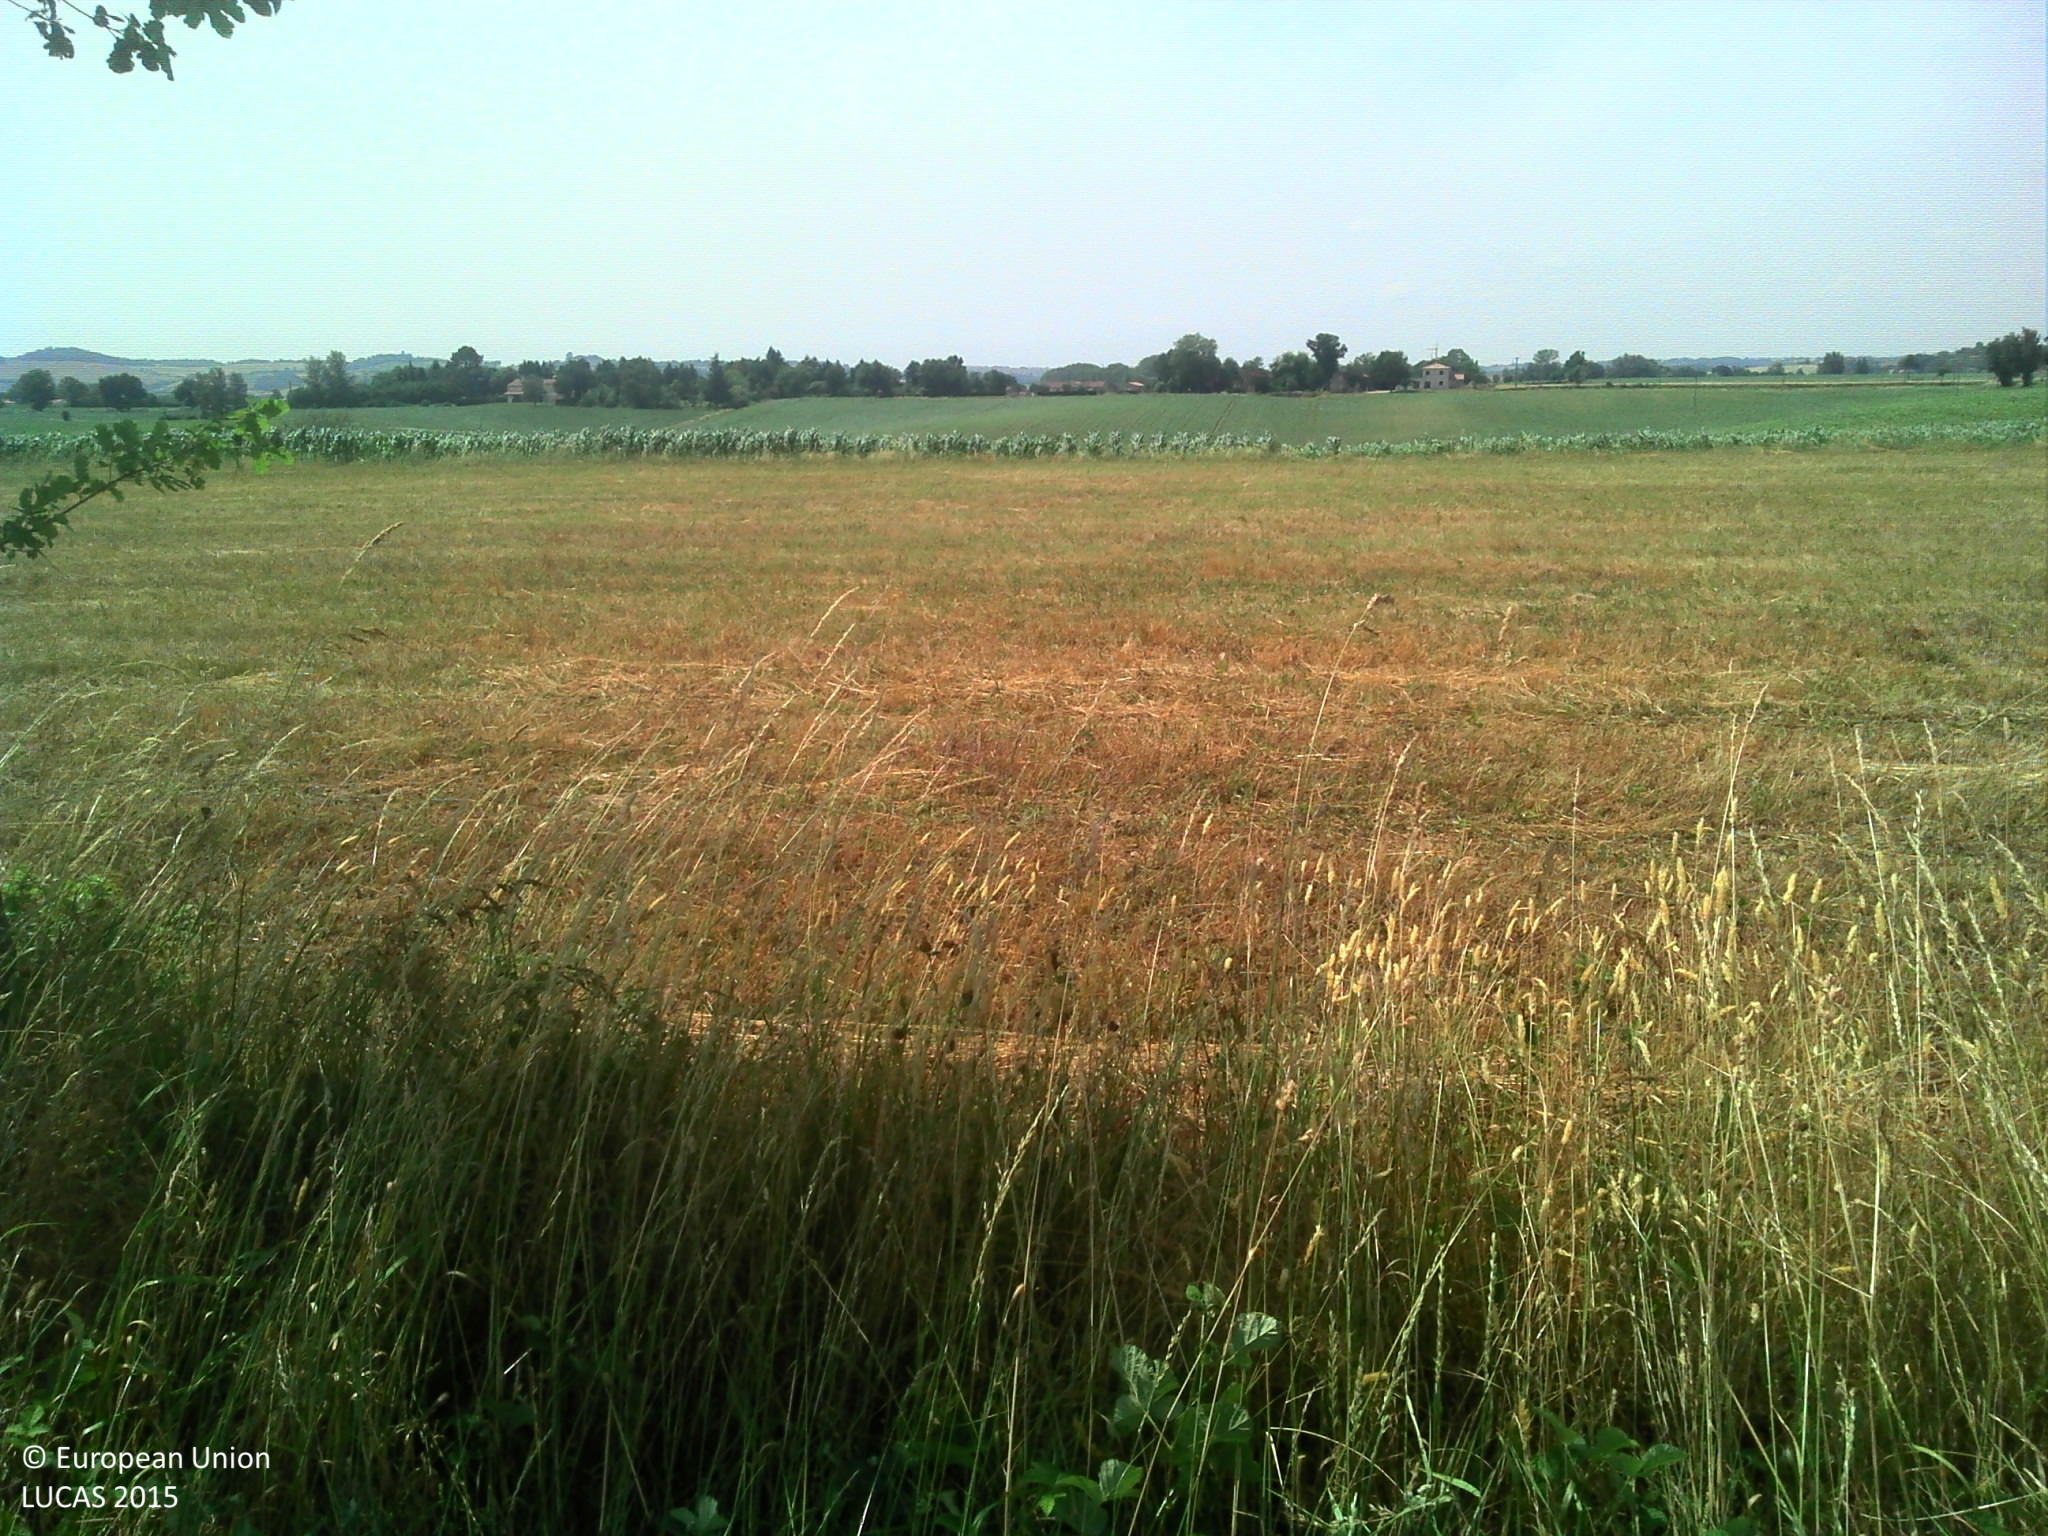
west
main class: Cropland
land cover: Durum wheat
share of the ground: > 75 %
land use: Agriculture (excluding fallow land and kitchen gardens)
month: June
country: FR
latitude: 43.5339
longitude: 1.9990
